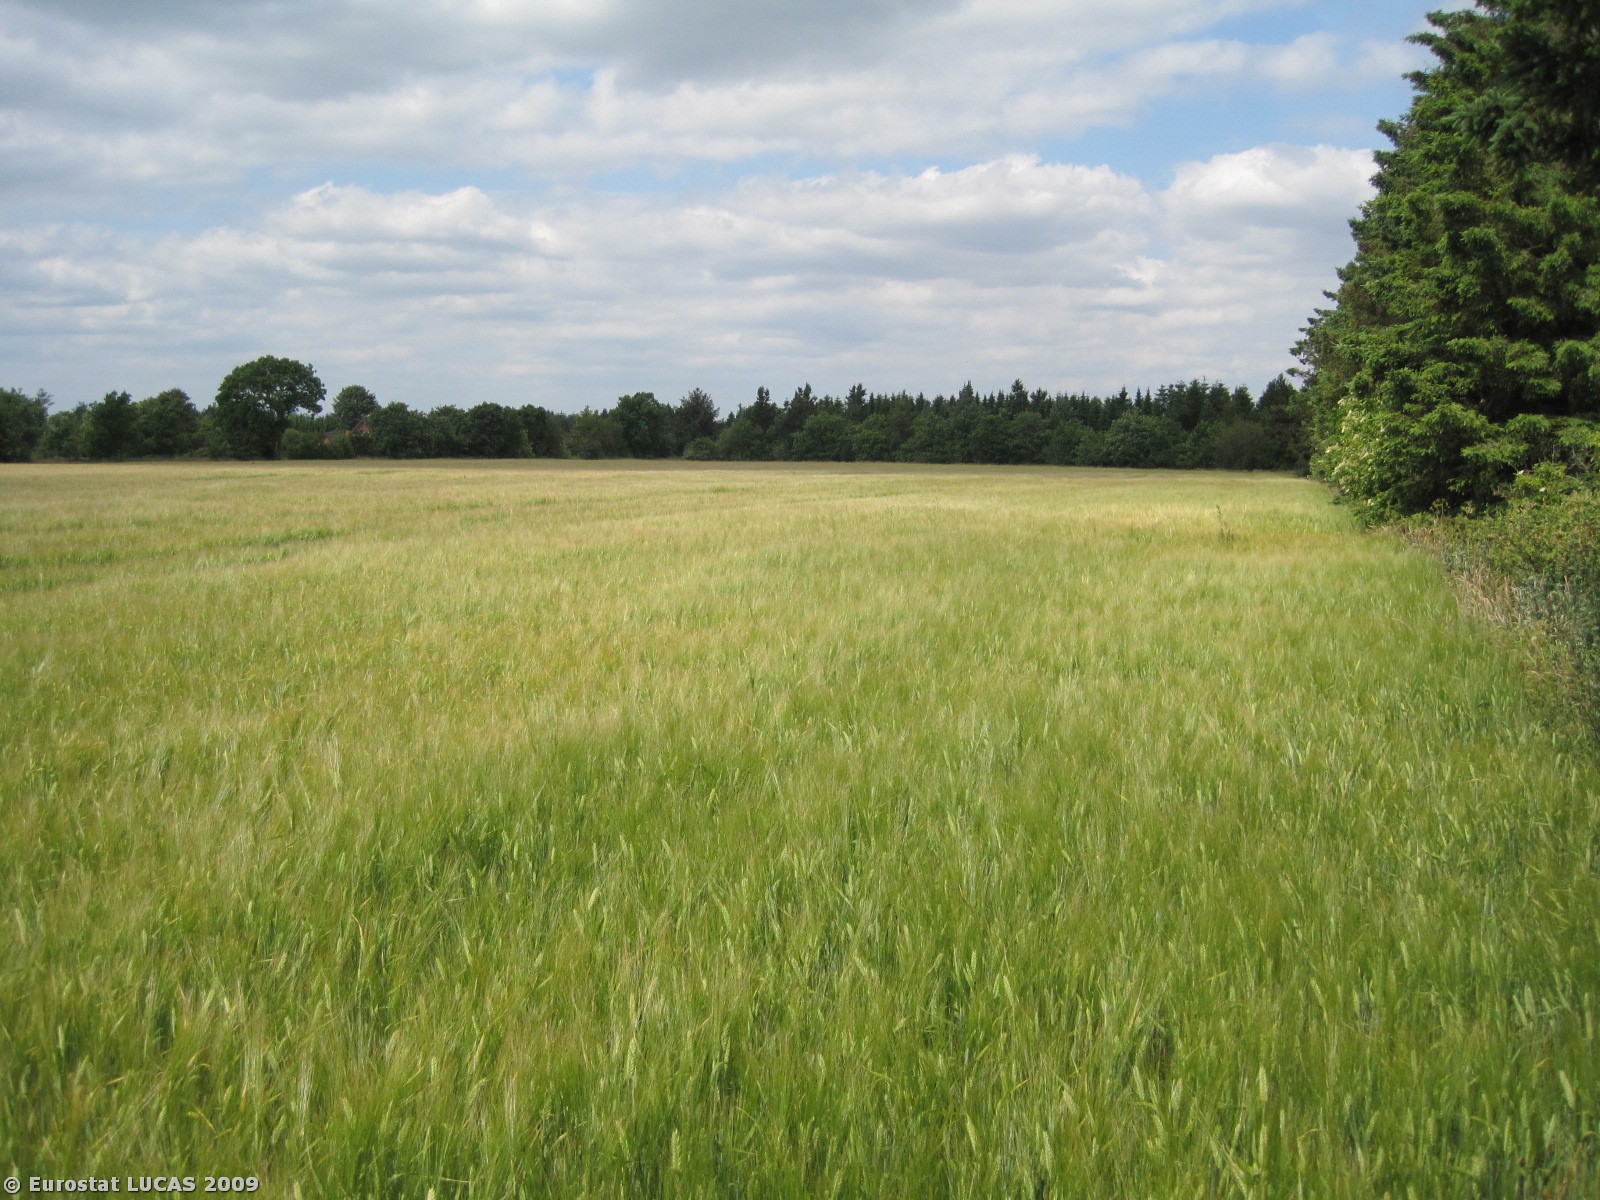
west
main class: Cropland
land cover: Barley
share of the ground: > 75 %
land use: Agriculture (excluding fallow land and kitchen gardens)
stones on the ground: < 10 %
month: June
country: DK
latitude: 56.3255
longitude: 8.7563
